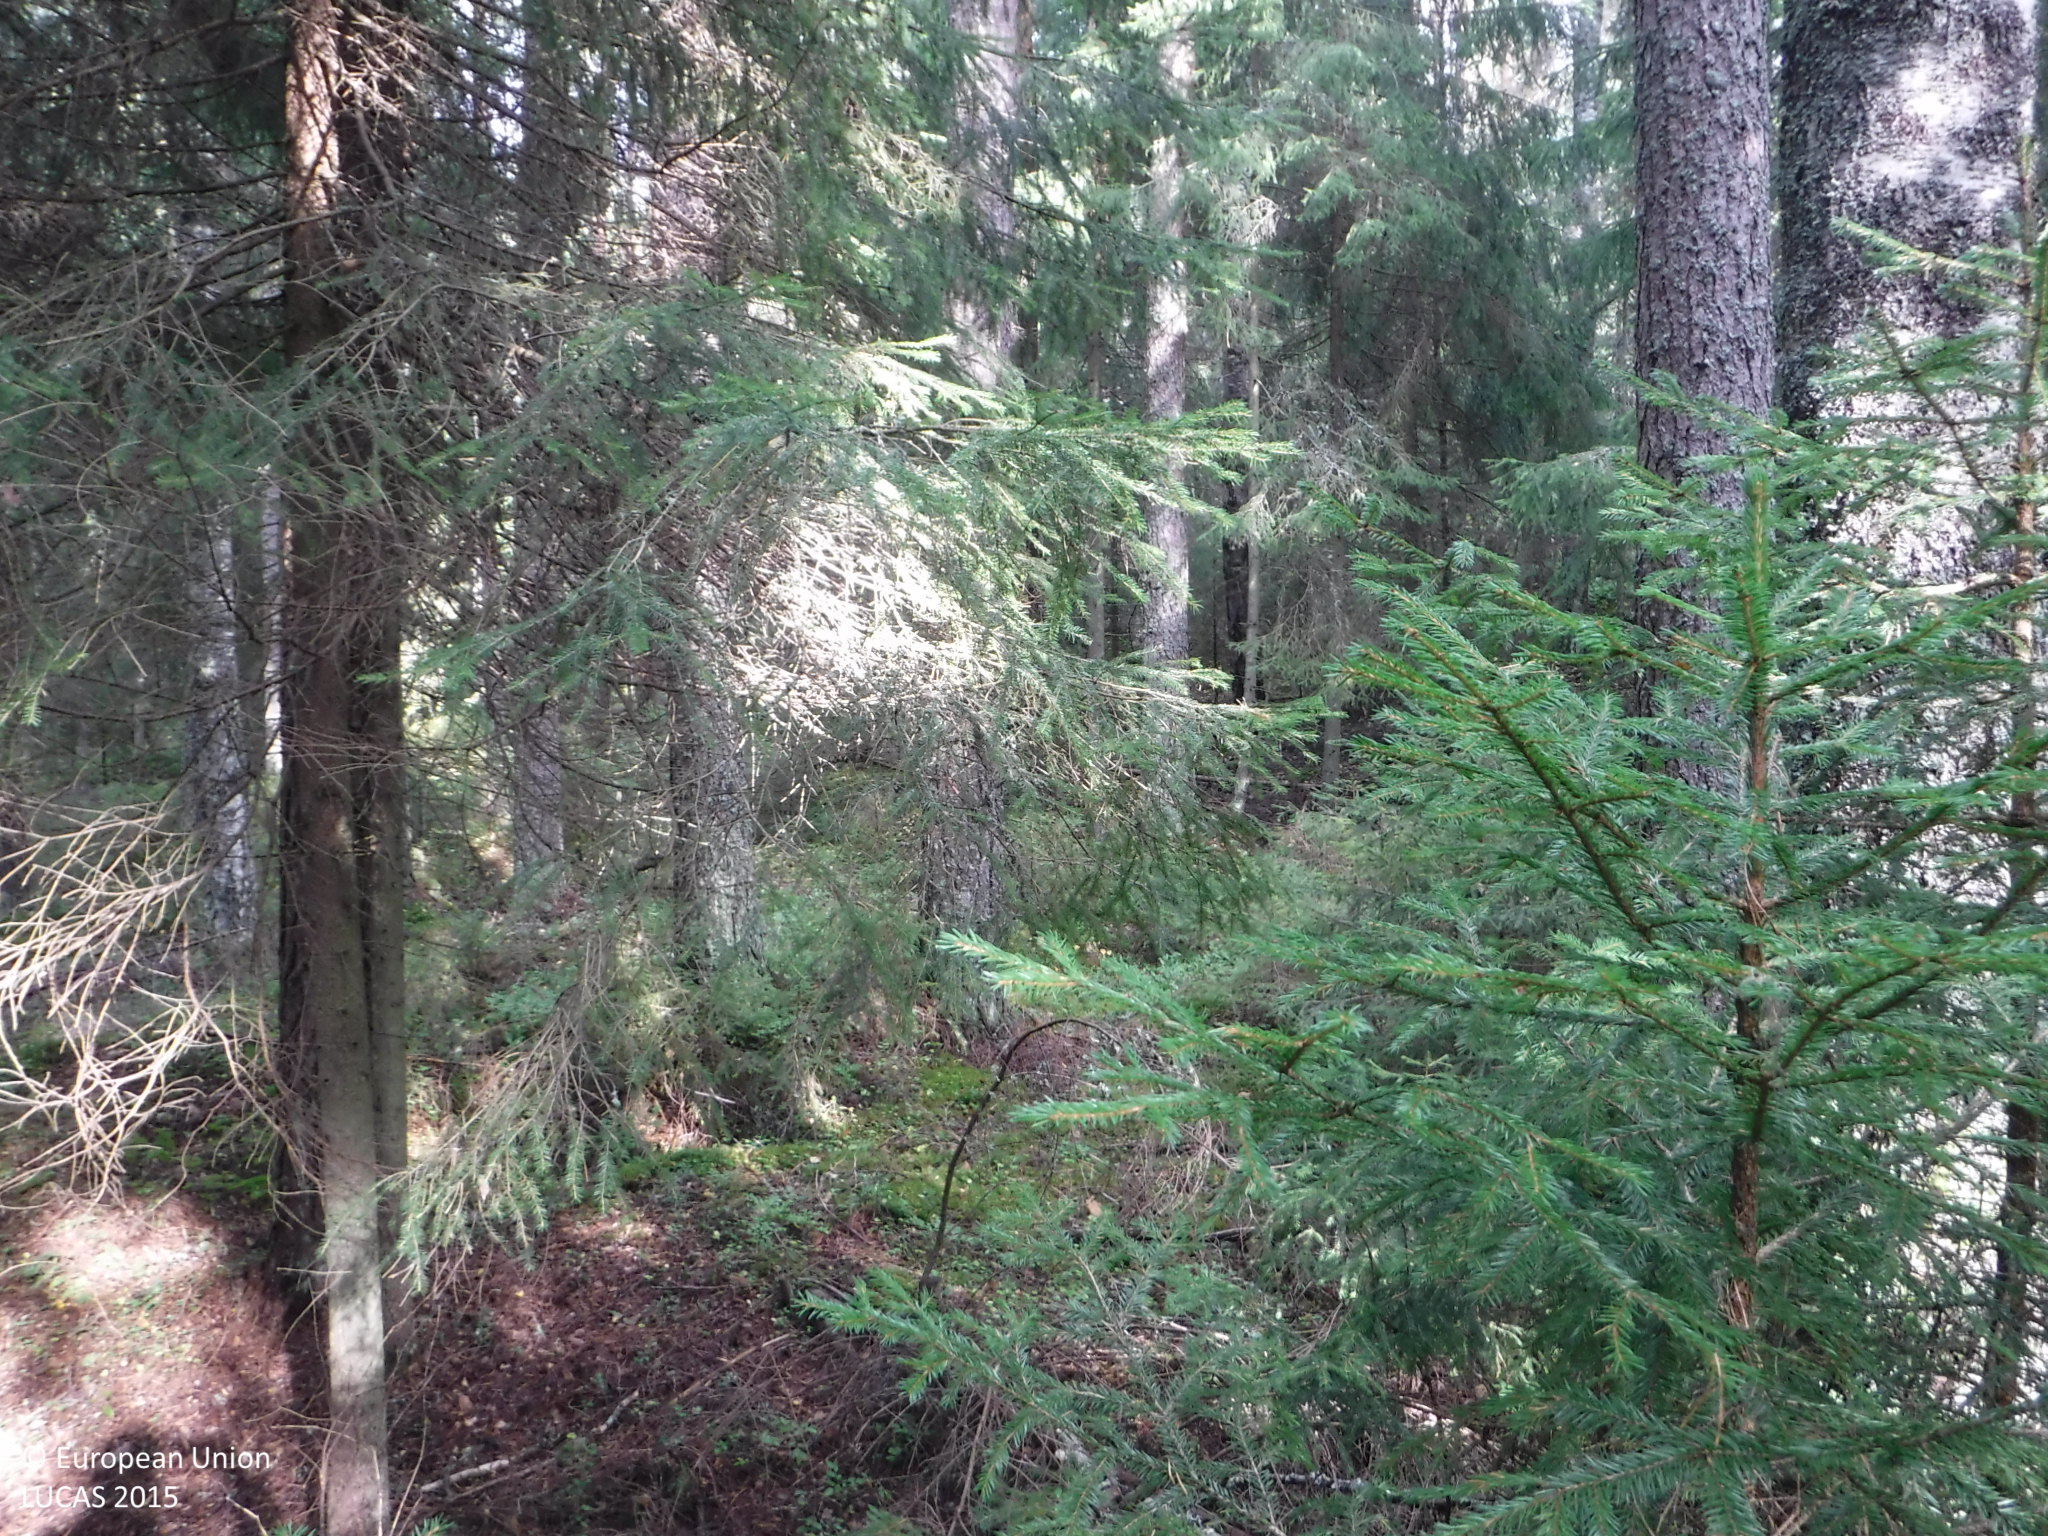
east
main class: Woodland
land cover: Other mixed woodland
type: boreal forest
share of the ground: > 75 %
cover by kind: coniferous forest trees 50 %, broadleaved forest trees 25 %, lichens and mosses 15 %, shrubs 10 %
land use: Forestry
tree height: > 5 m
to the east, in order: Other mixed woodland; Other coniferous woodland; Tracks; Electric lines; Spruce dominated coniferous woodland; Pine dominated coniferous woodland
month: September
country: FI
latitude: 61.4004
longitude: 23.0503
